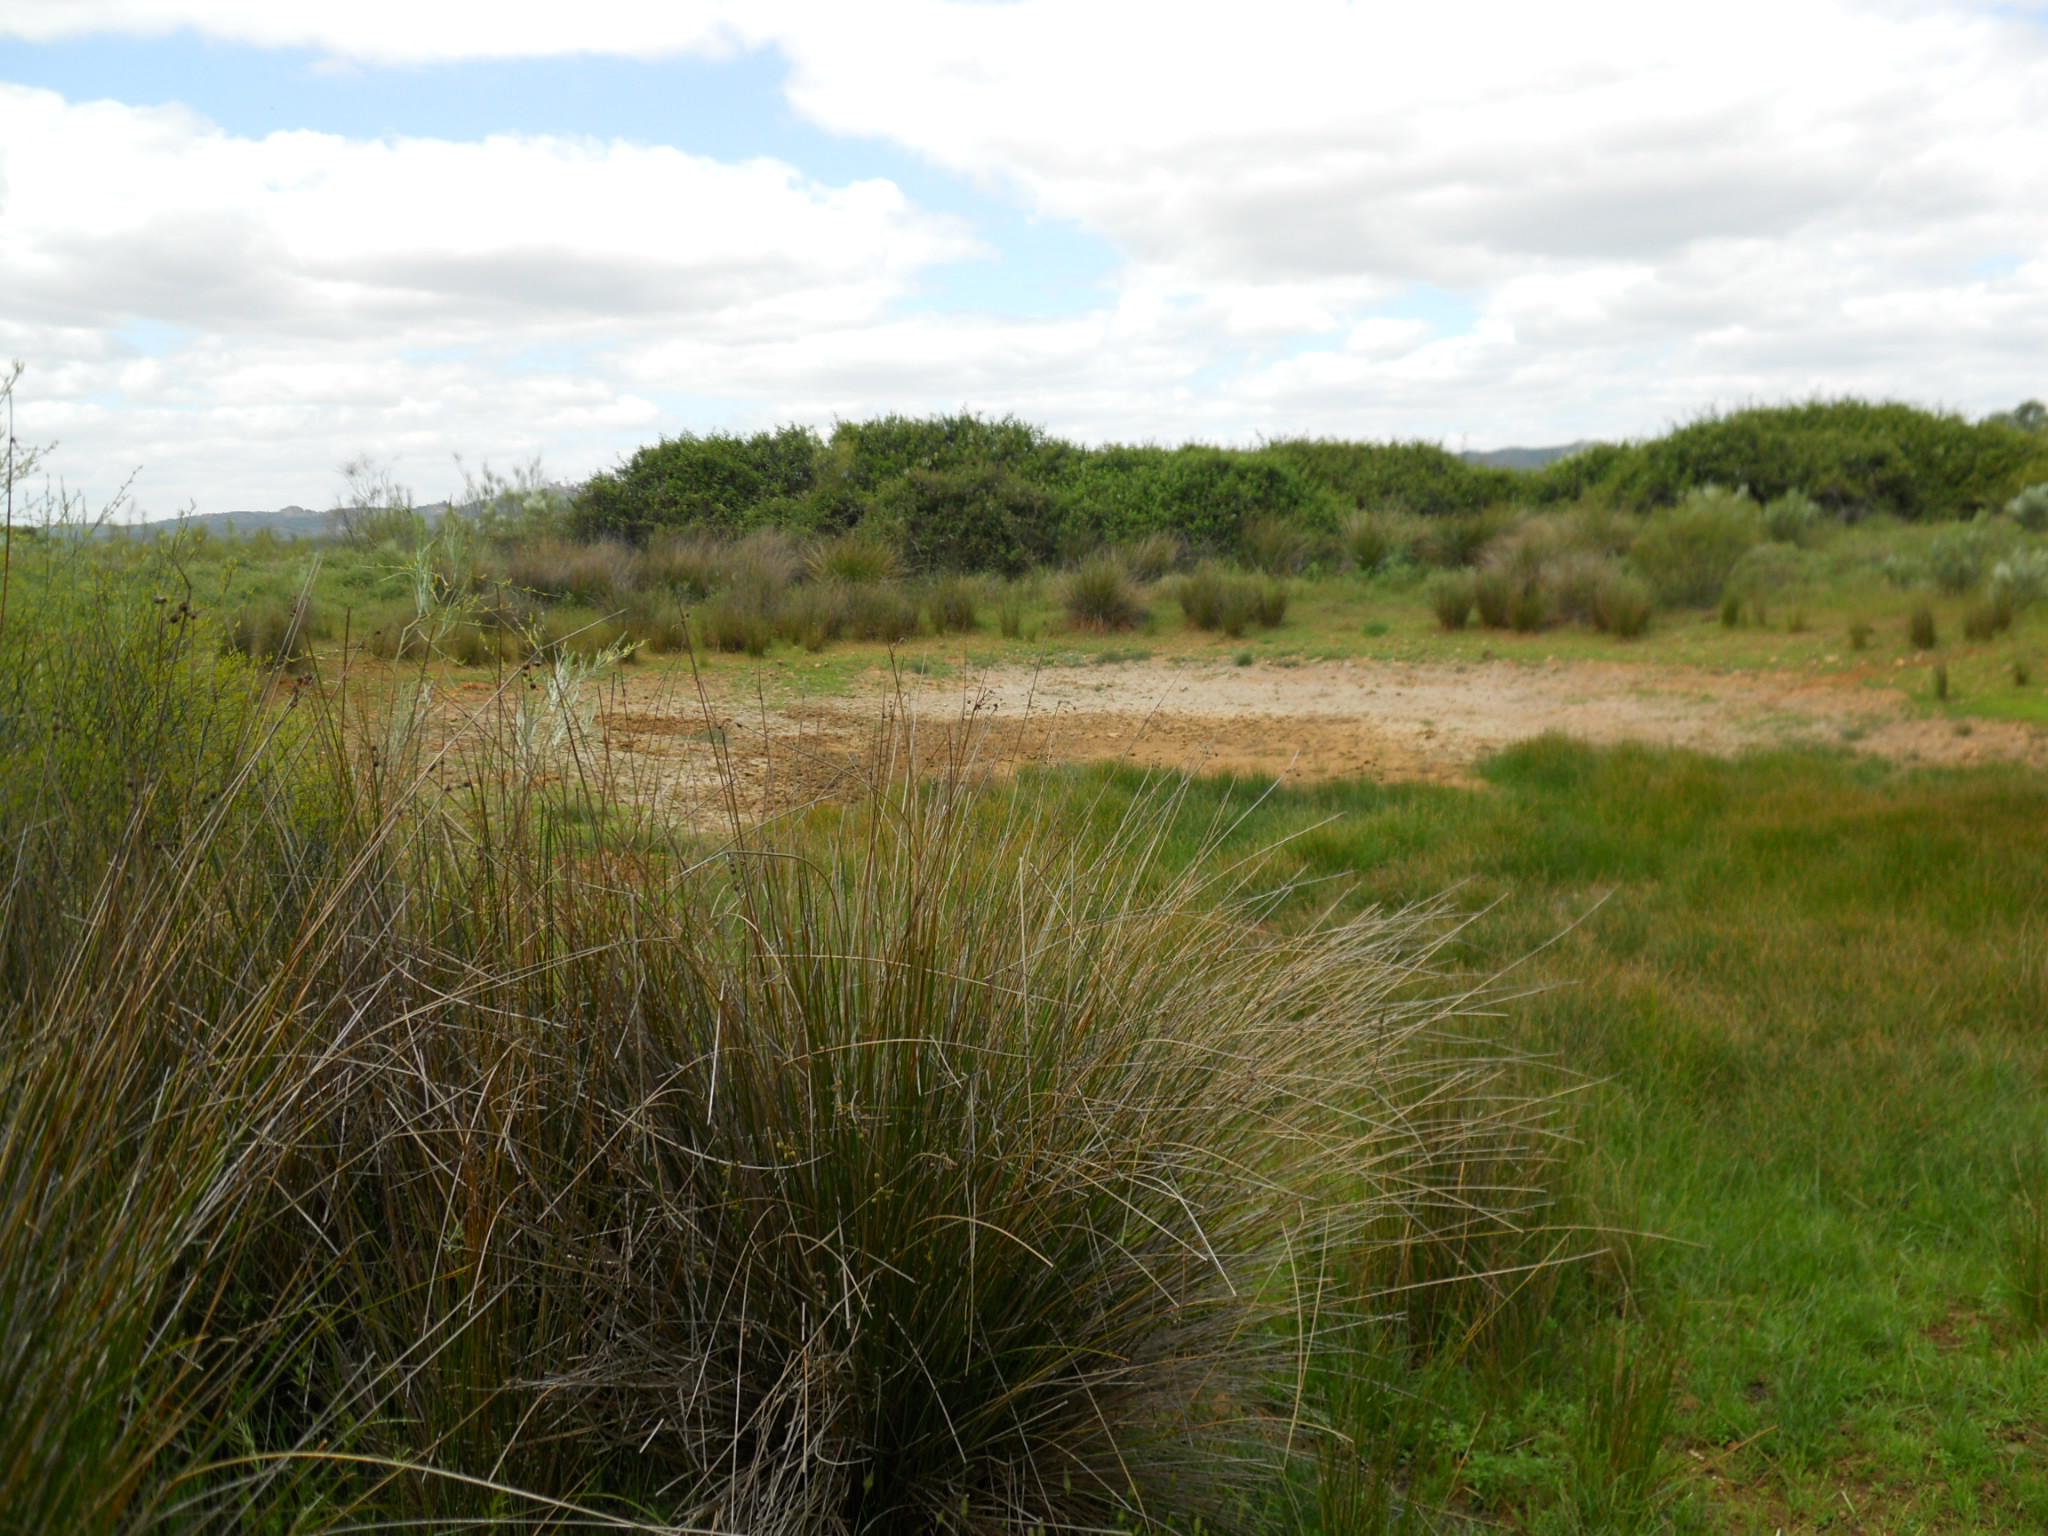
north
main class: Shrubland
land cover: Shrubland with sparse tree cover
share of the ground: > 75 %
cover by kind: shrubs 80 %, herbaceous plants 15 %, broadleaved forest trees 5 %
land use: Agriculture (excluding fallow land and kitchen gardens)
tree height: > 5 m
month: May
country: ES
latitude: 39.1616
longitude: -6.9835
